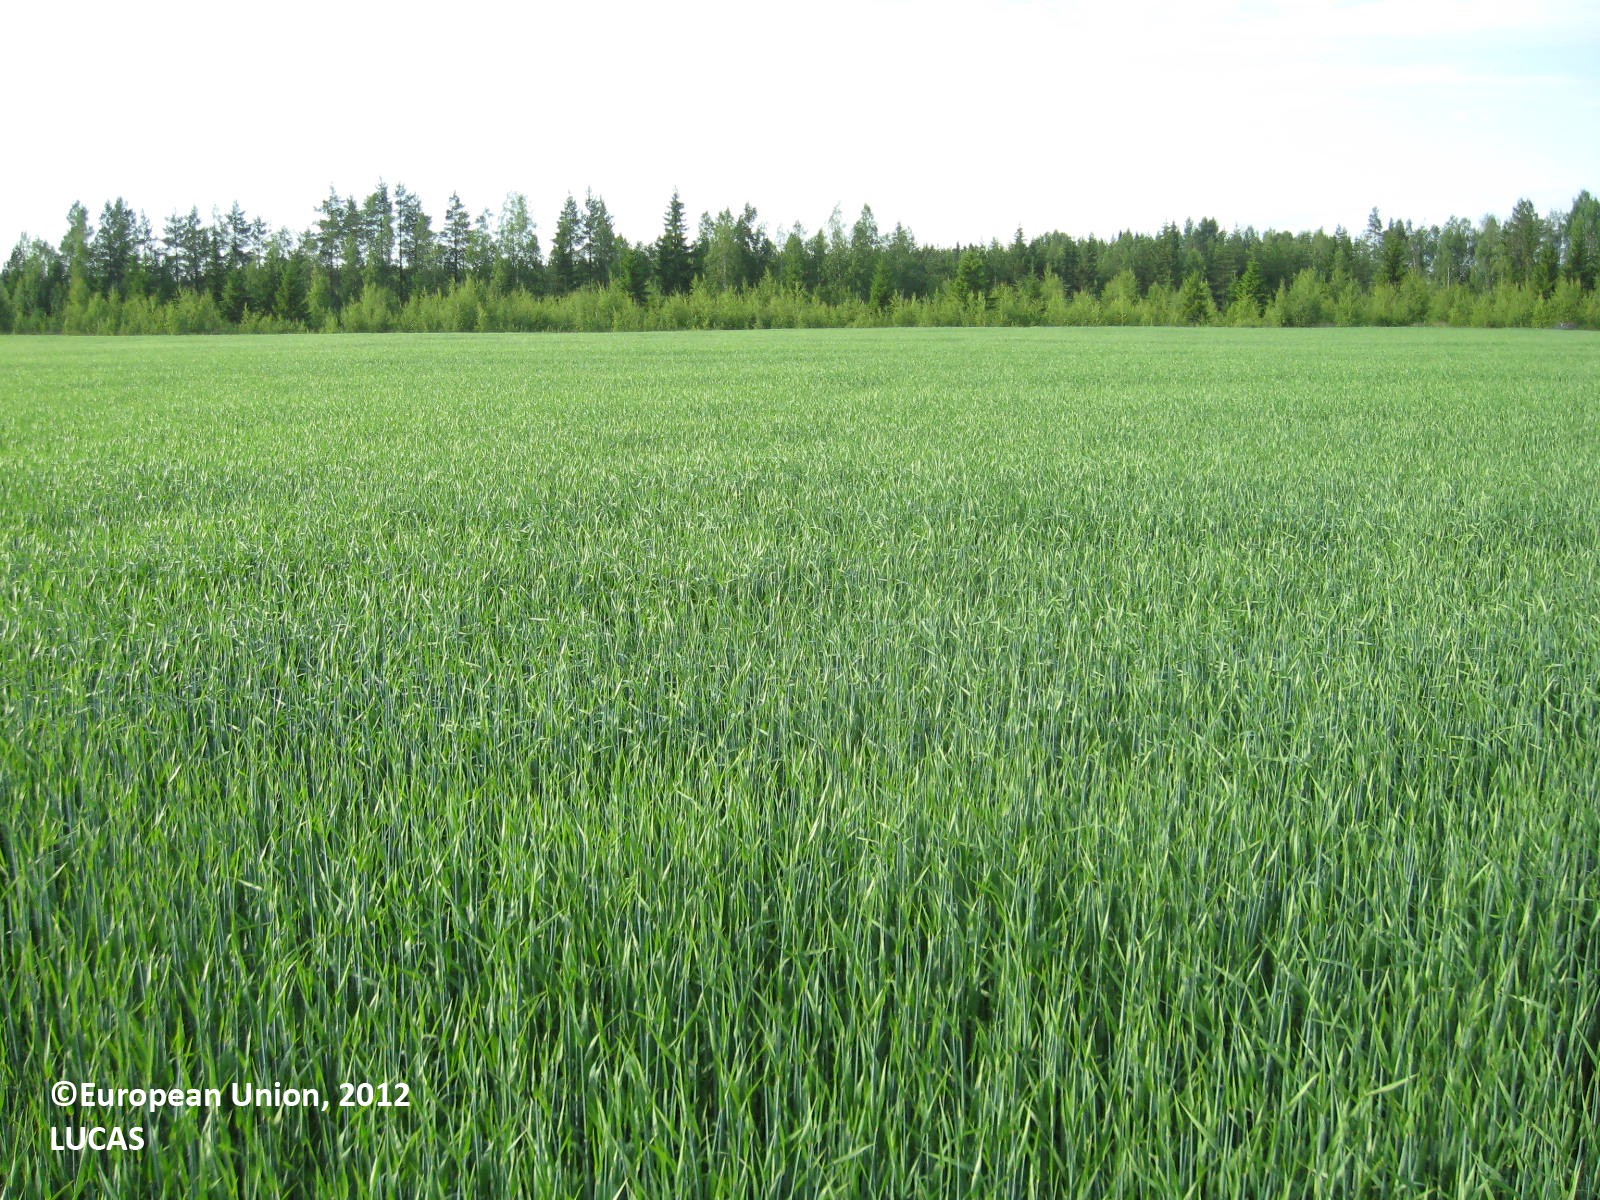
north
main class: Cropland
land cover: Barley
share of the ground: > 75 %
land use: Agriculture (excluding fallow land and kitchen gardens)
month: July
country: FI
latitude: 62.5183
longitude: 21.7198
